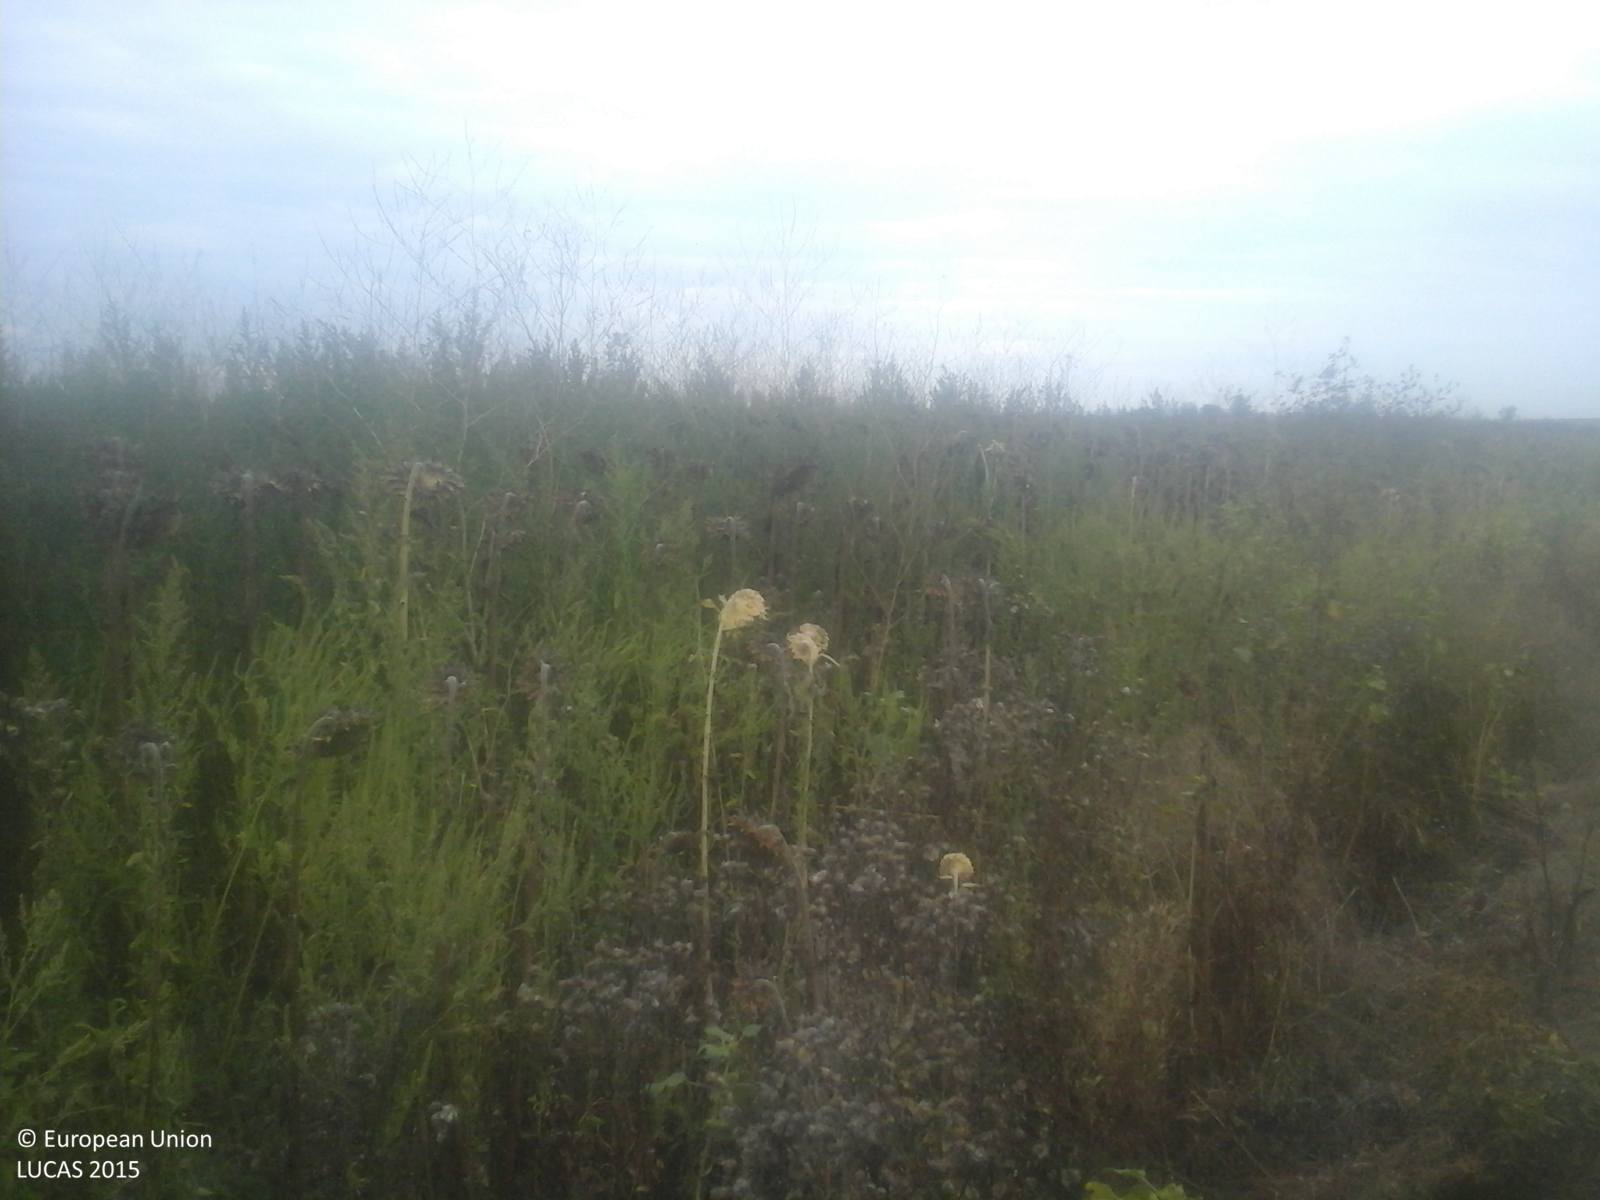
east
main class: Cropland
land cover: Sunflower
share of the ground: > 75 %
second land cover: Spontaneously vegetated surfaces
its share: > 75 %
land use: Agriculture (excluding fallow land and kitchen gardens)
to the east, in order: Sunflower; Spontaneously vegetated surfaces; Lucerne; Sunflower
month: September
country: RO
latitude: 47.7415
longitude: 22.6908
